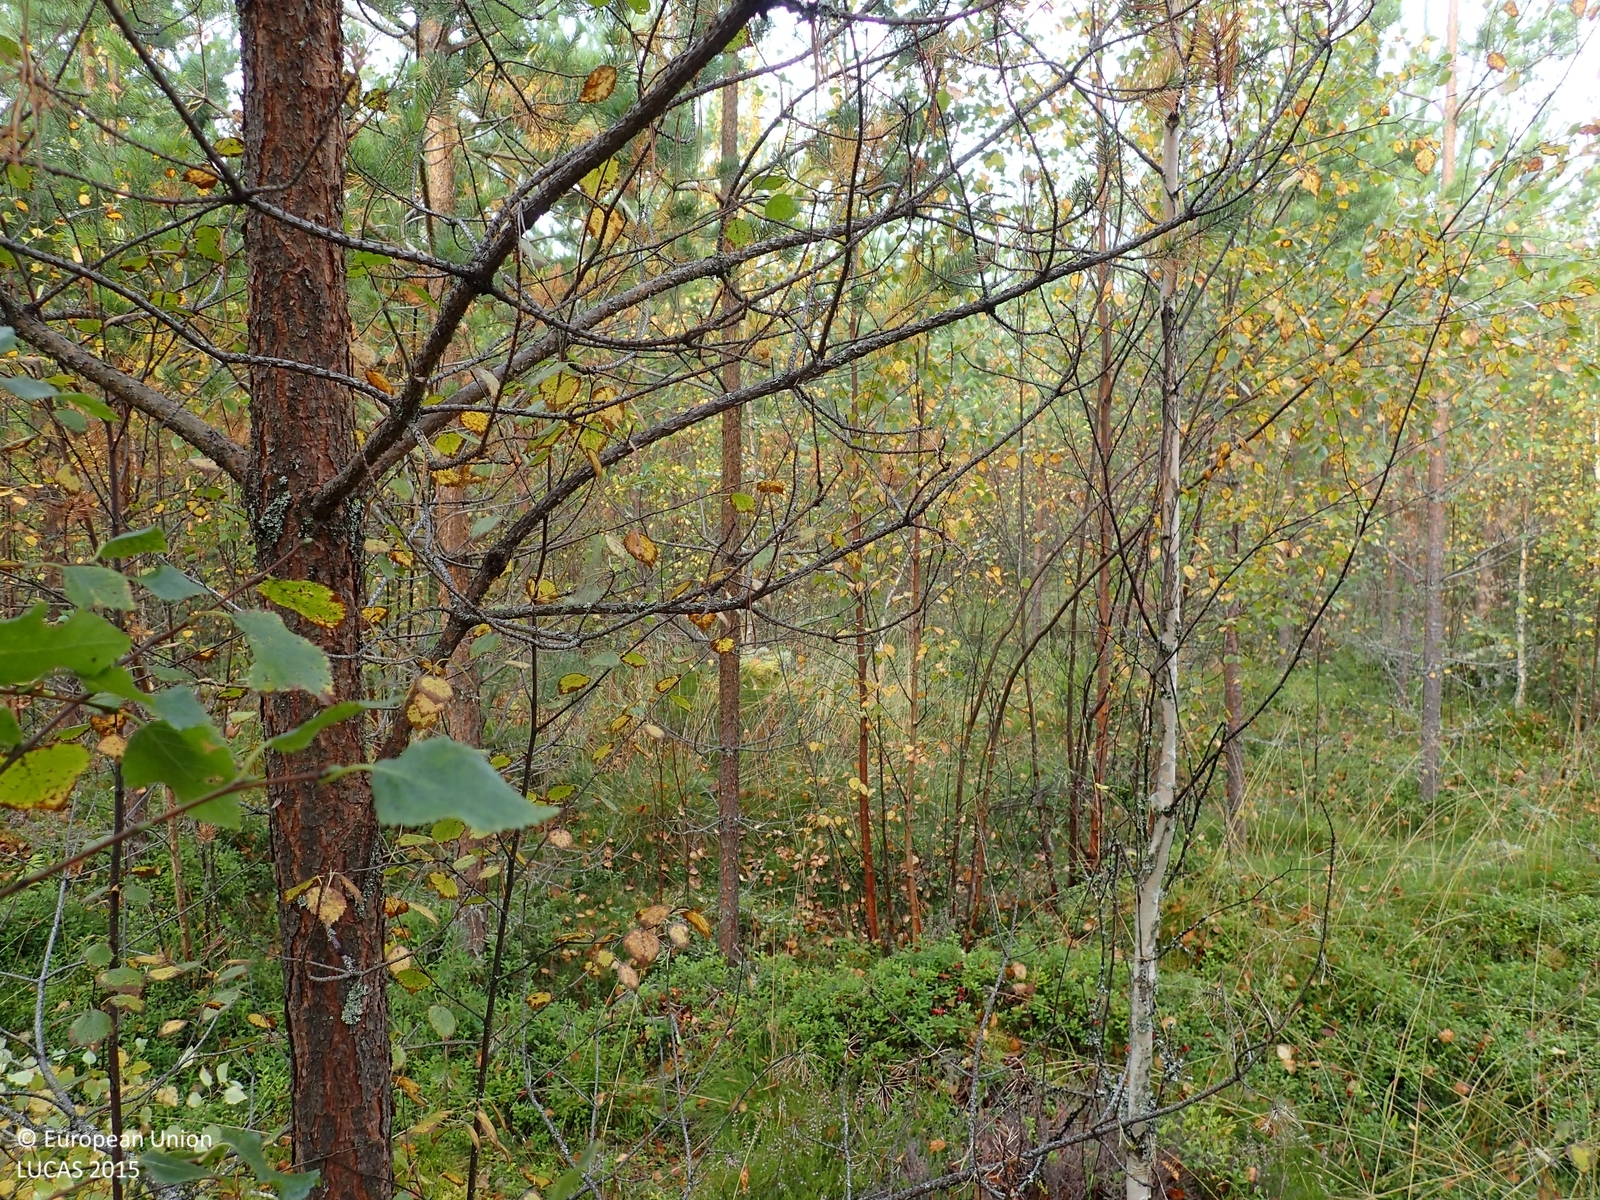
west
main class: Woodland
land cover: Pine dominated mixed woodland
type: boreal forest
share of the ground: > 75 %
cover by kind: coniferous forest trees 60 %, broadleaved forest trees 20 %, shrubs 10 %, herbaceous plants 5 %, lichens and mosses 5 %
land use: Forestry
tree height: < 5 m
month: September
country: FI
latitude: 63.1337
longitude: 26.0050
